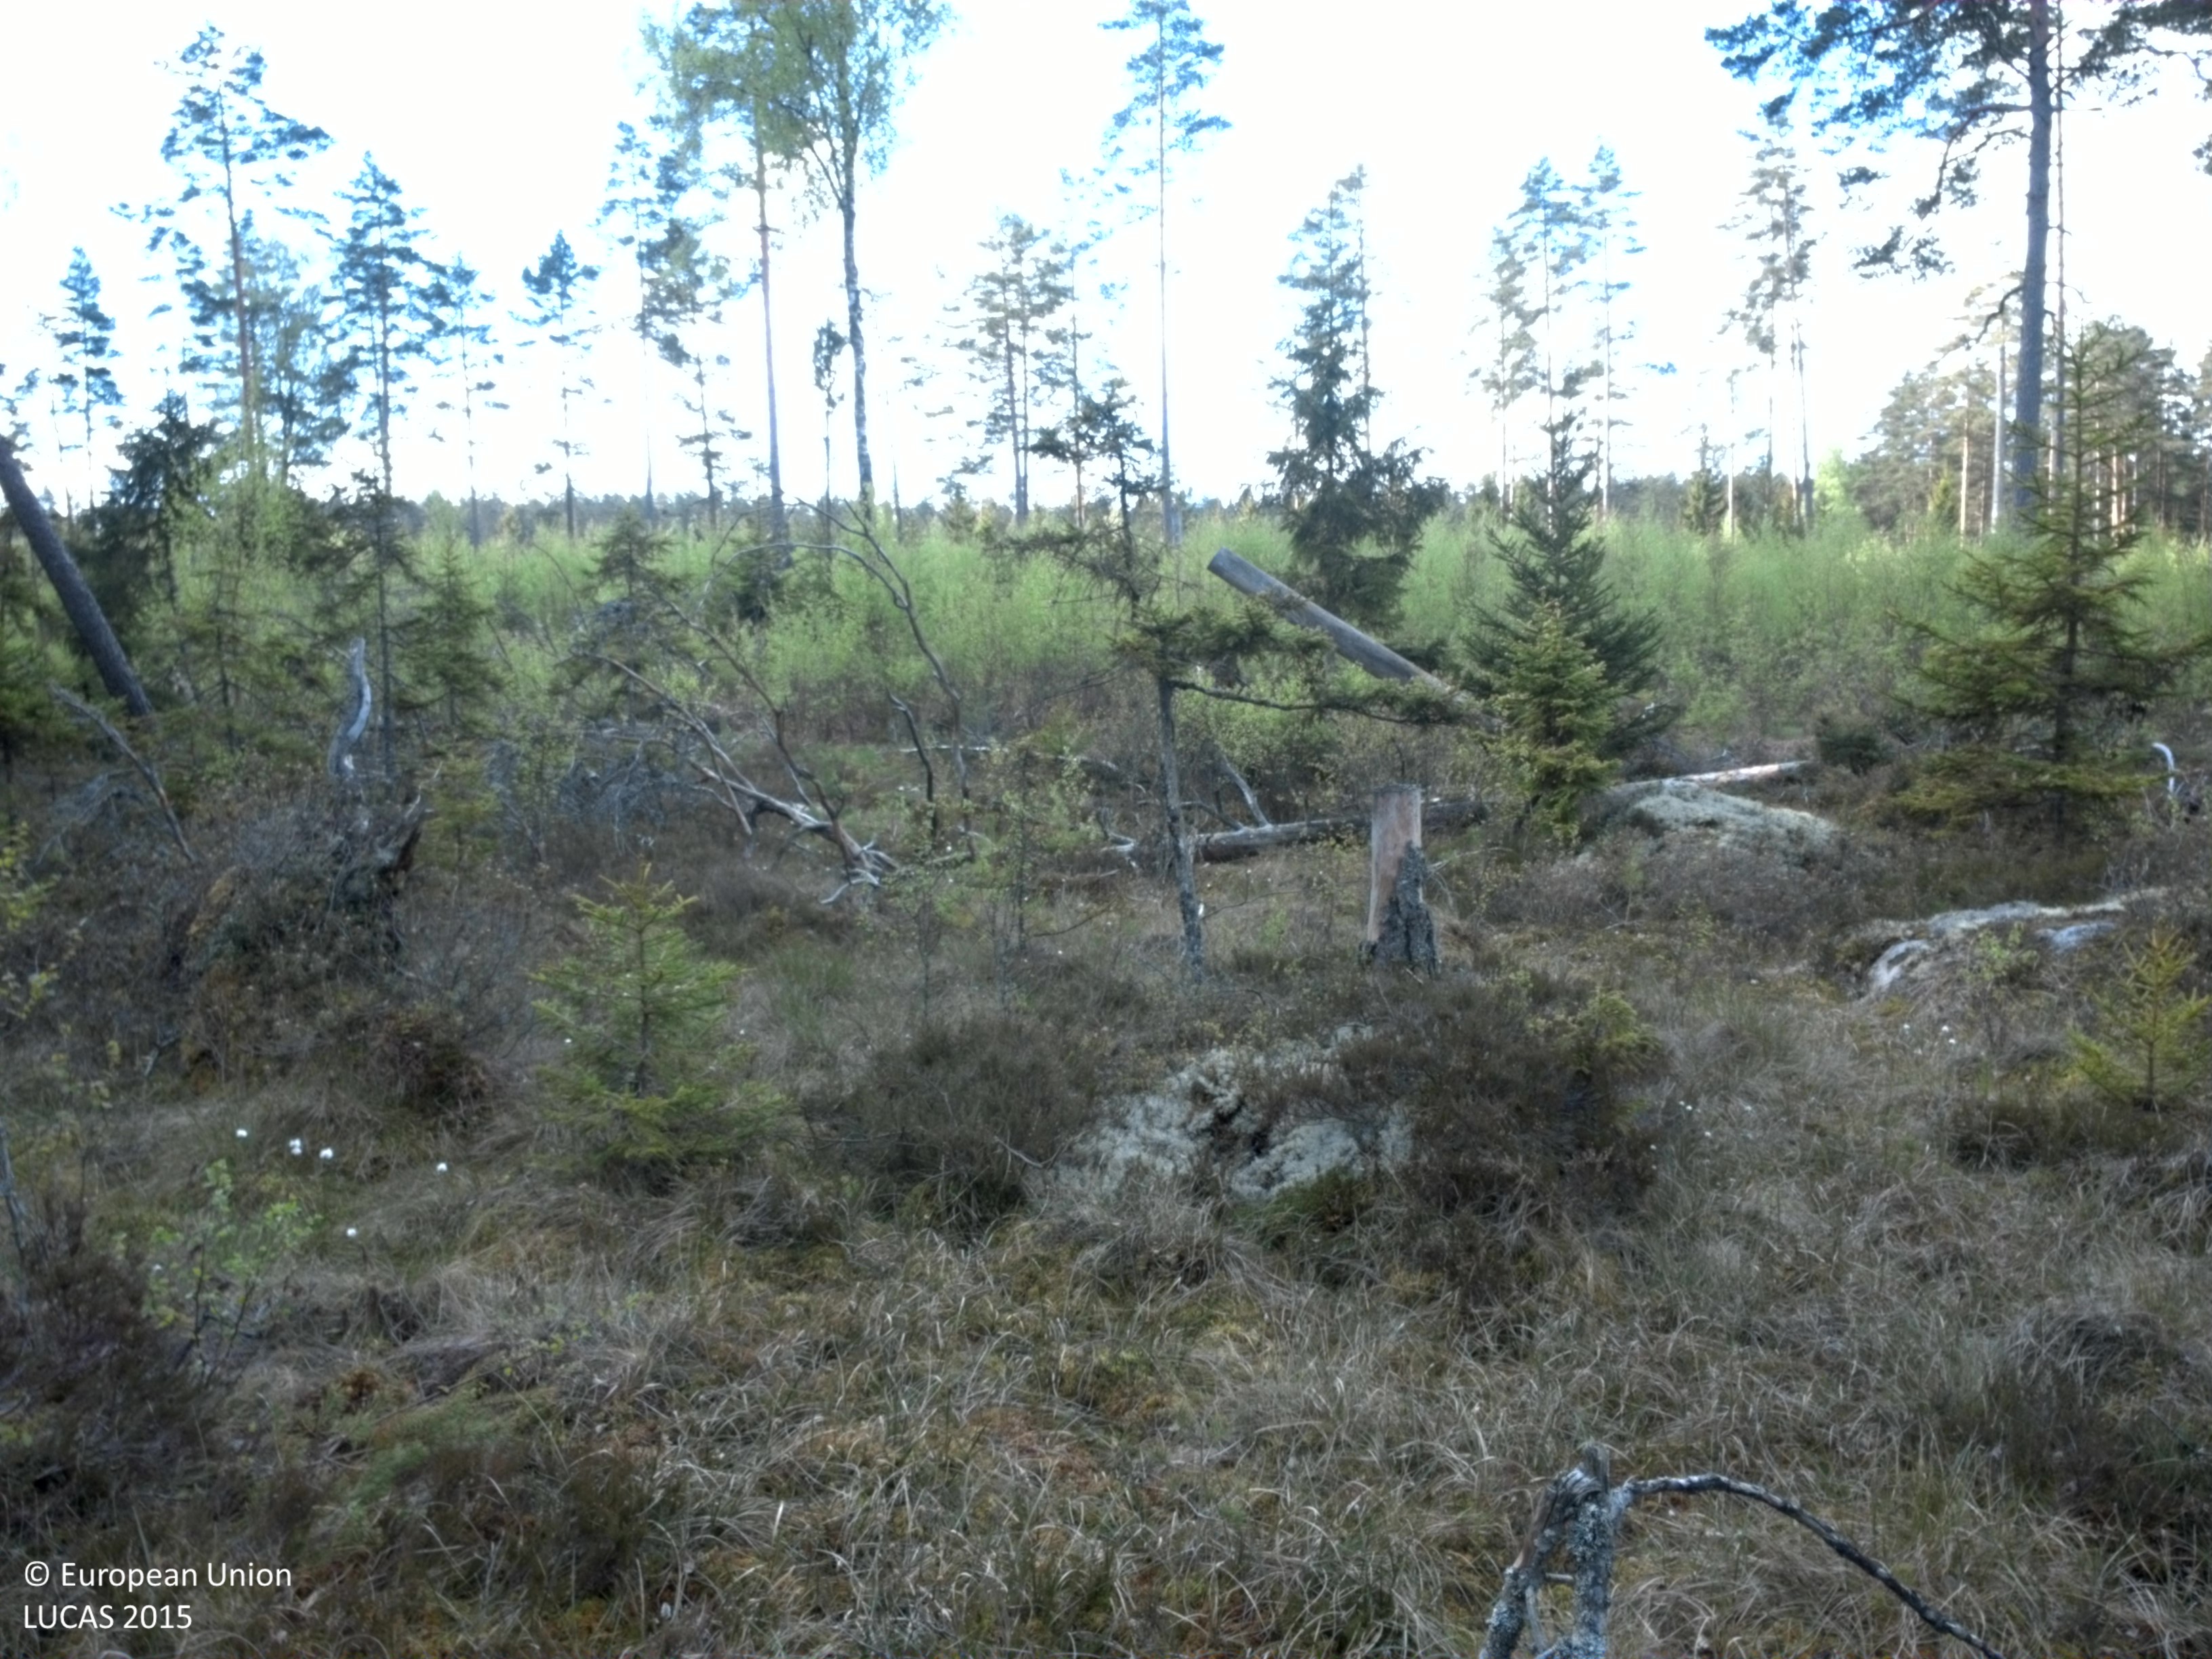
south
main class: Woodland
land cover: Pine dominated mixed woodland
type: boreal forest
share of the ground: 50 - 75 %
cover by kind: coniferous forest trees 35 %, broadleaved forest trees 35 %, lichens and mosses 30 %
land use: Forestry
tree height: > 5 m
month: May
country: SE
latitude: 56.5926
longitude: 14.5735
